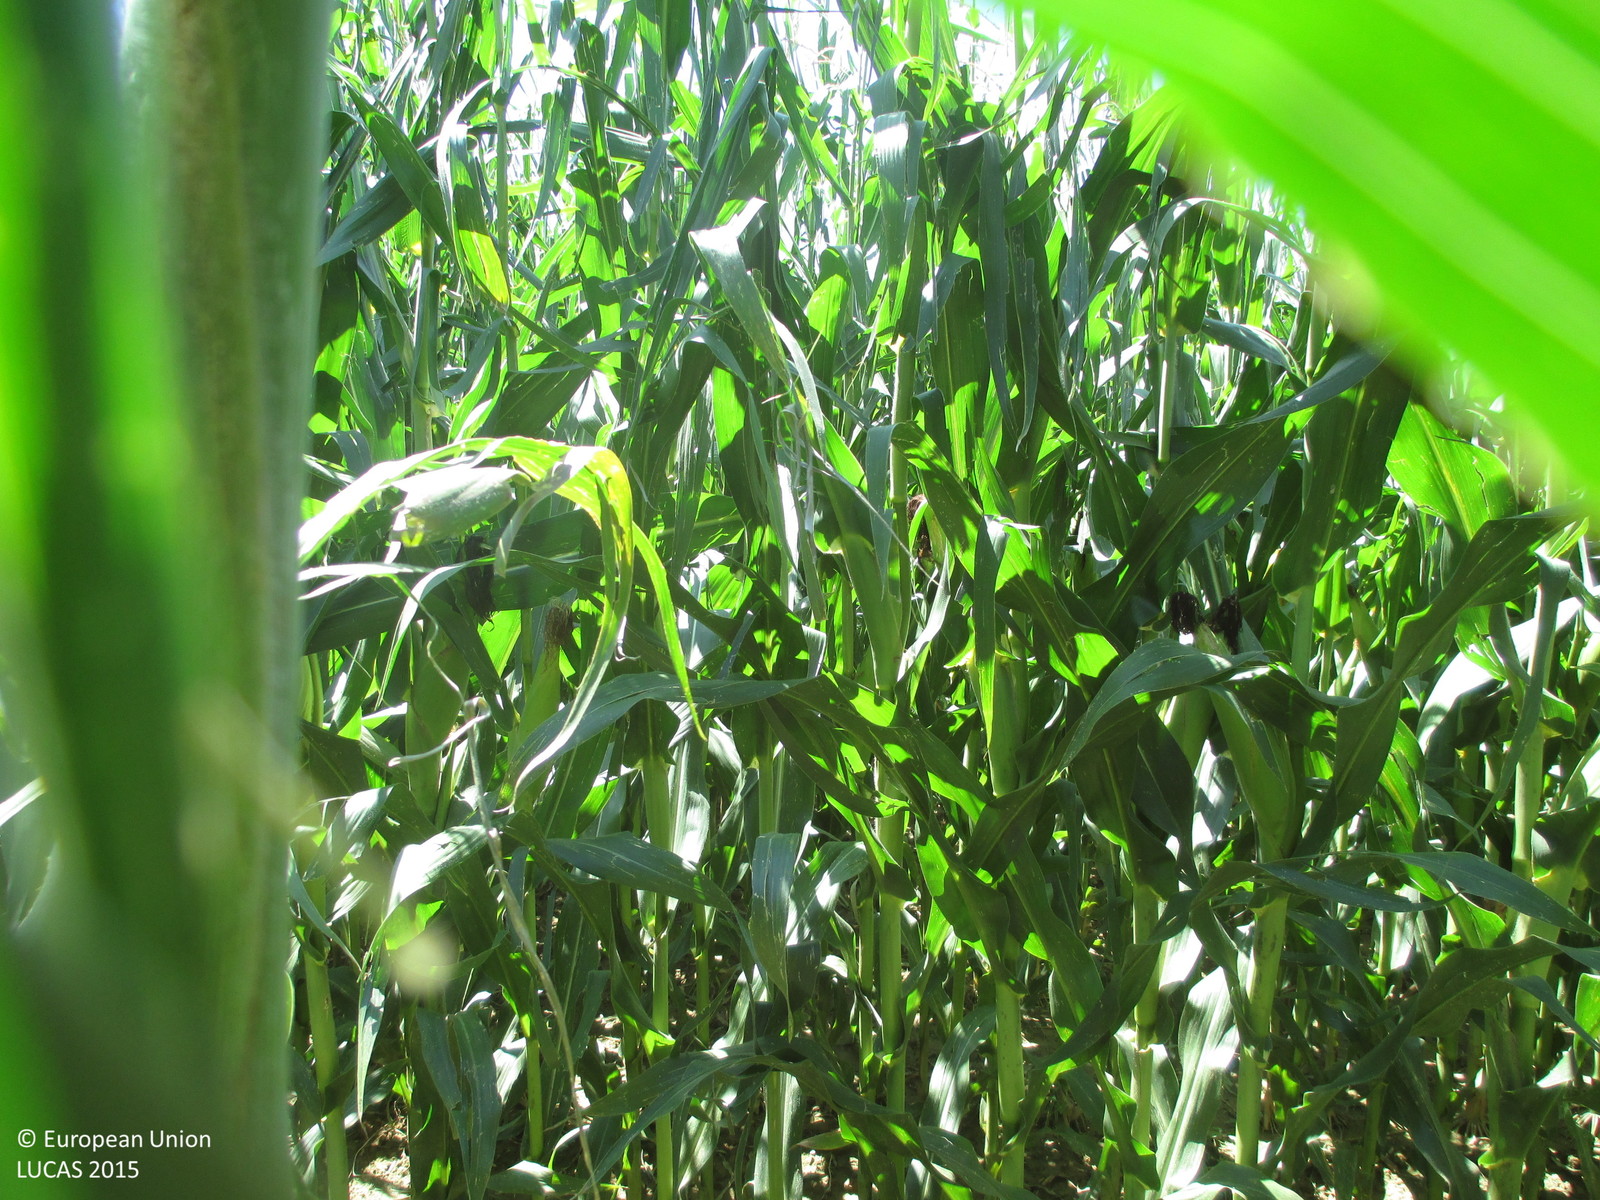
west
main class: Cropland
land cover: Maize
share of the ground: > 75 %
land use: Agriculture (excluding fallow land and kitchen gardens)
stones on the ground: < 10 %
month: July
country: ES
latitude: 41.9320
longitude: 0.1053
